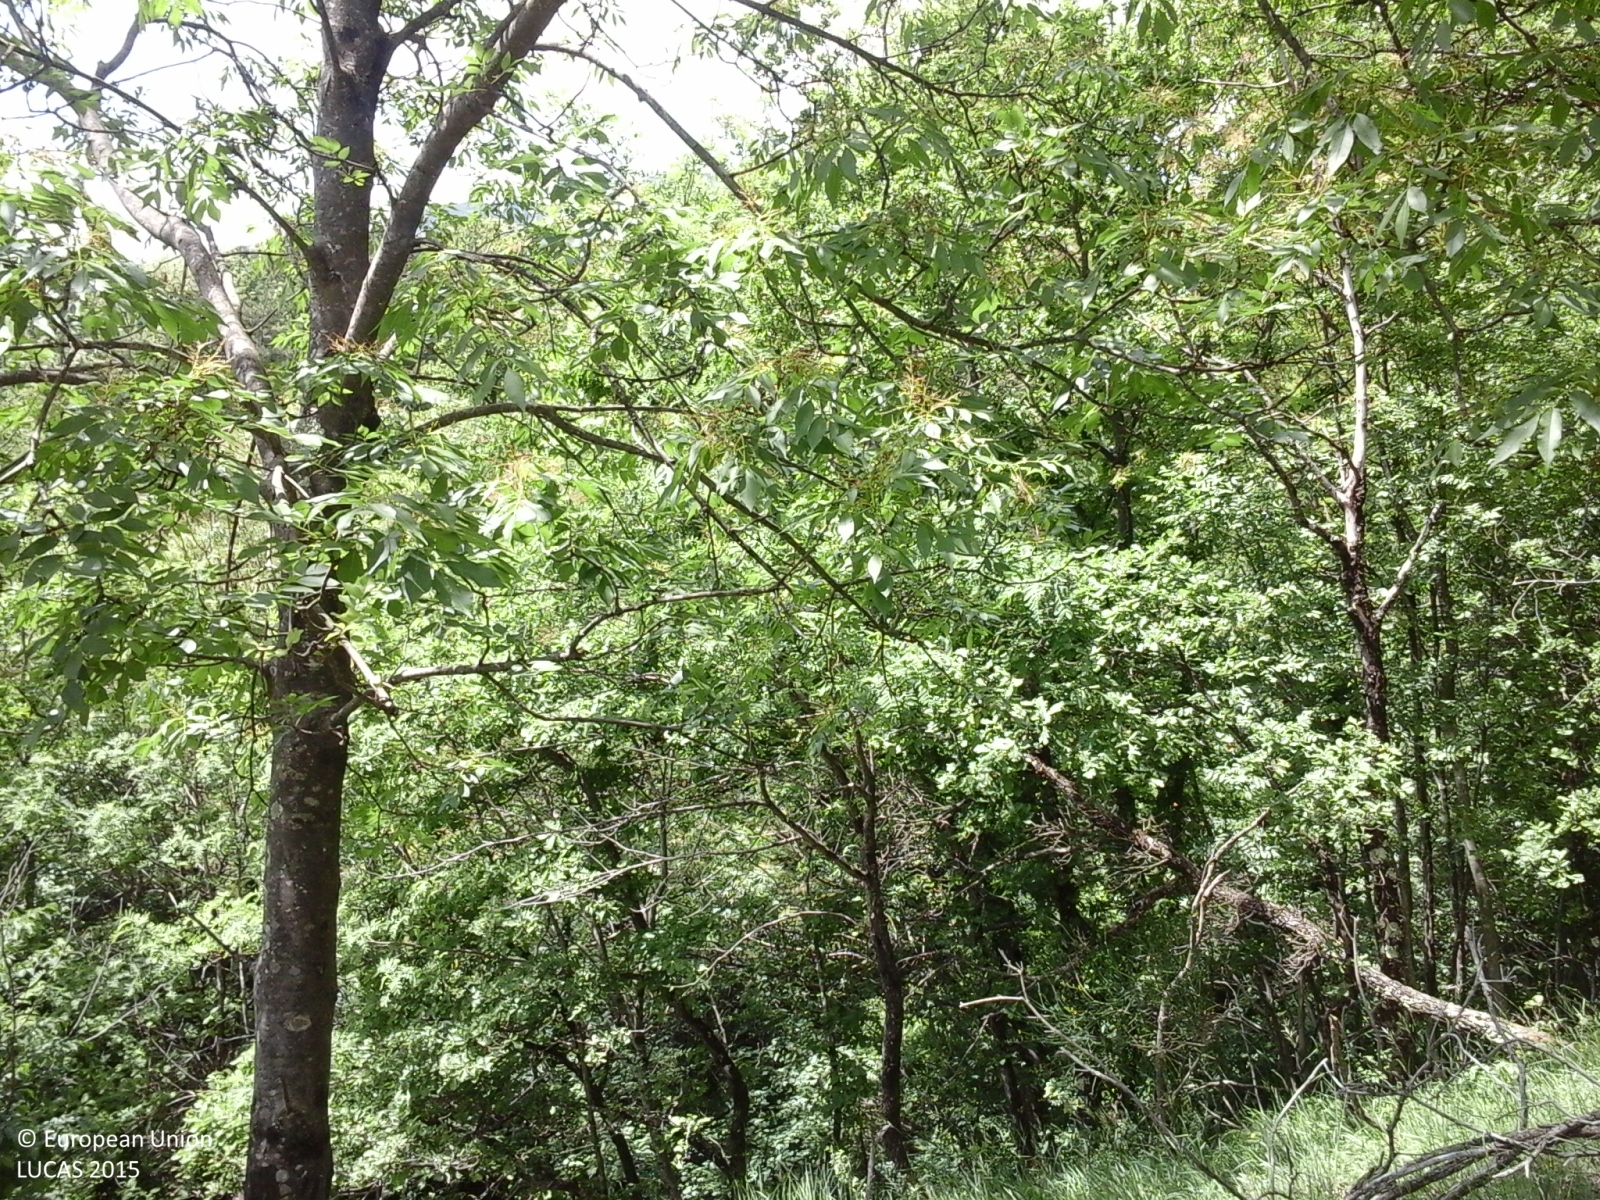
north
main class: Woodland
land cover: Broadleaved woodland
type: thermophilous deciduous forest
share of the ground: > 75 %
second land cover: Grassland without tree/shrub cover
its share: > 75 %
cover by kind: broadleaved forest trees 70 %, herbaceous plants 20 %, shrubs 10 %
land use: Forestry
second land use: Agriculture (excluding fallow land and kitchen gardens)
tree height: > 5 m
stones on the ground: 10 - 25 %
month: May
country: IT
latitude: 44.0380
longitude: 11.1079
